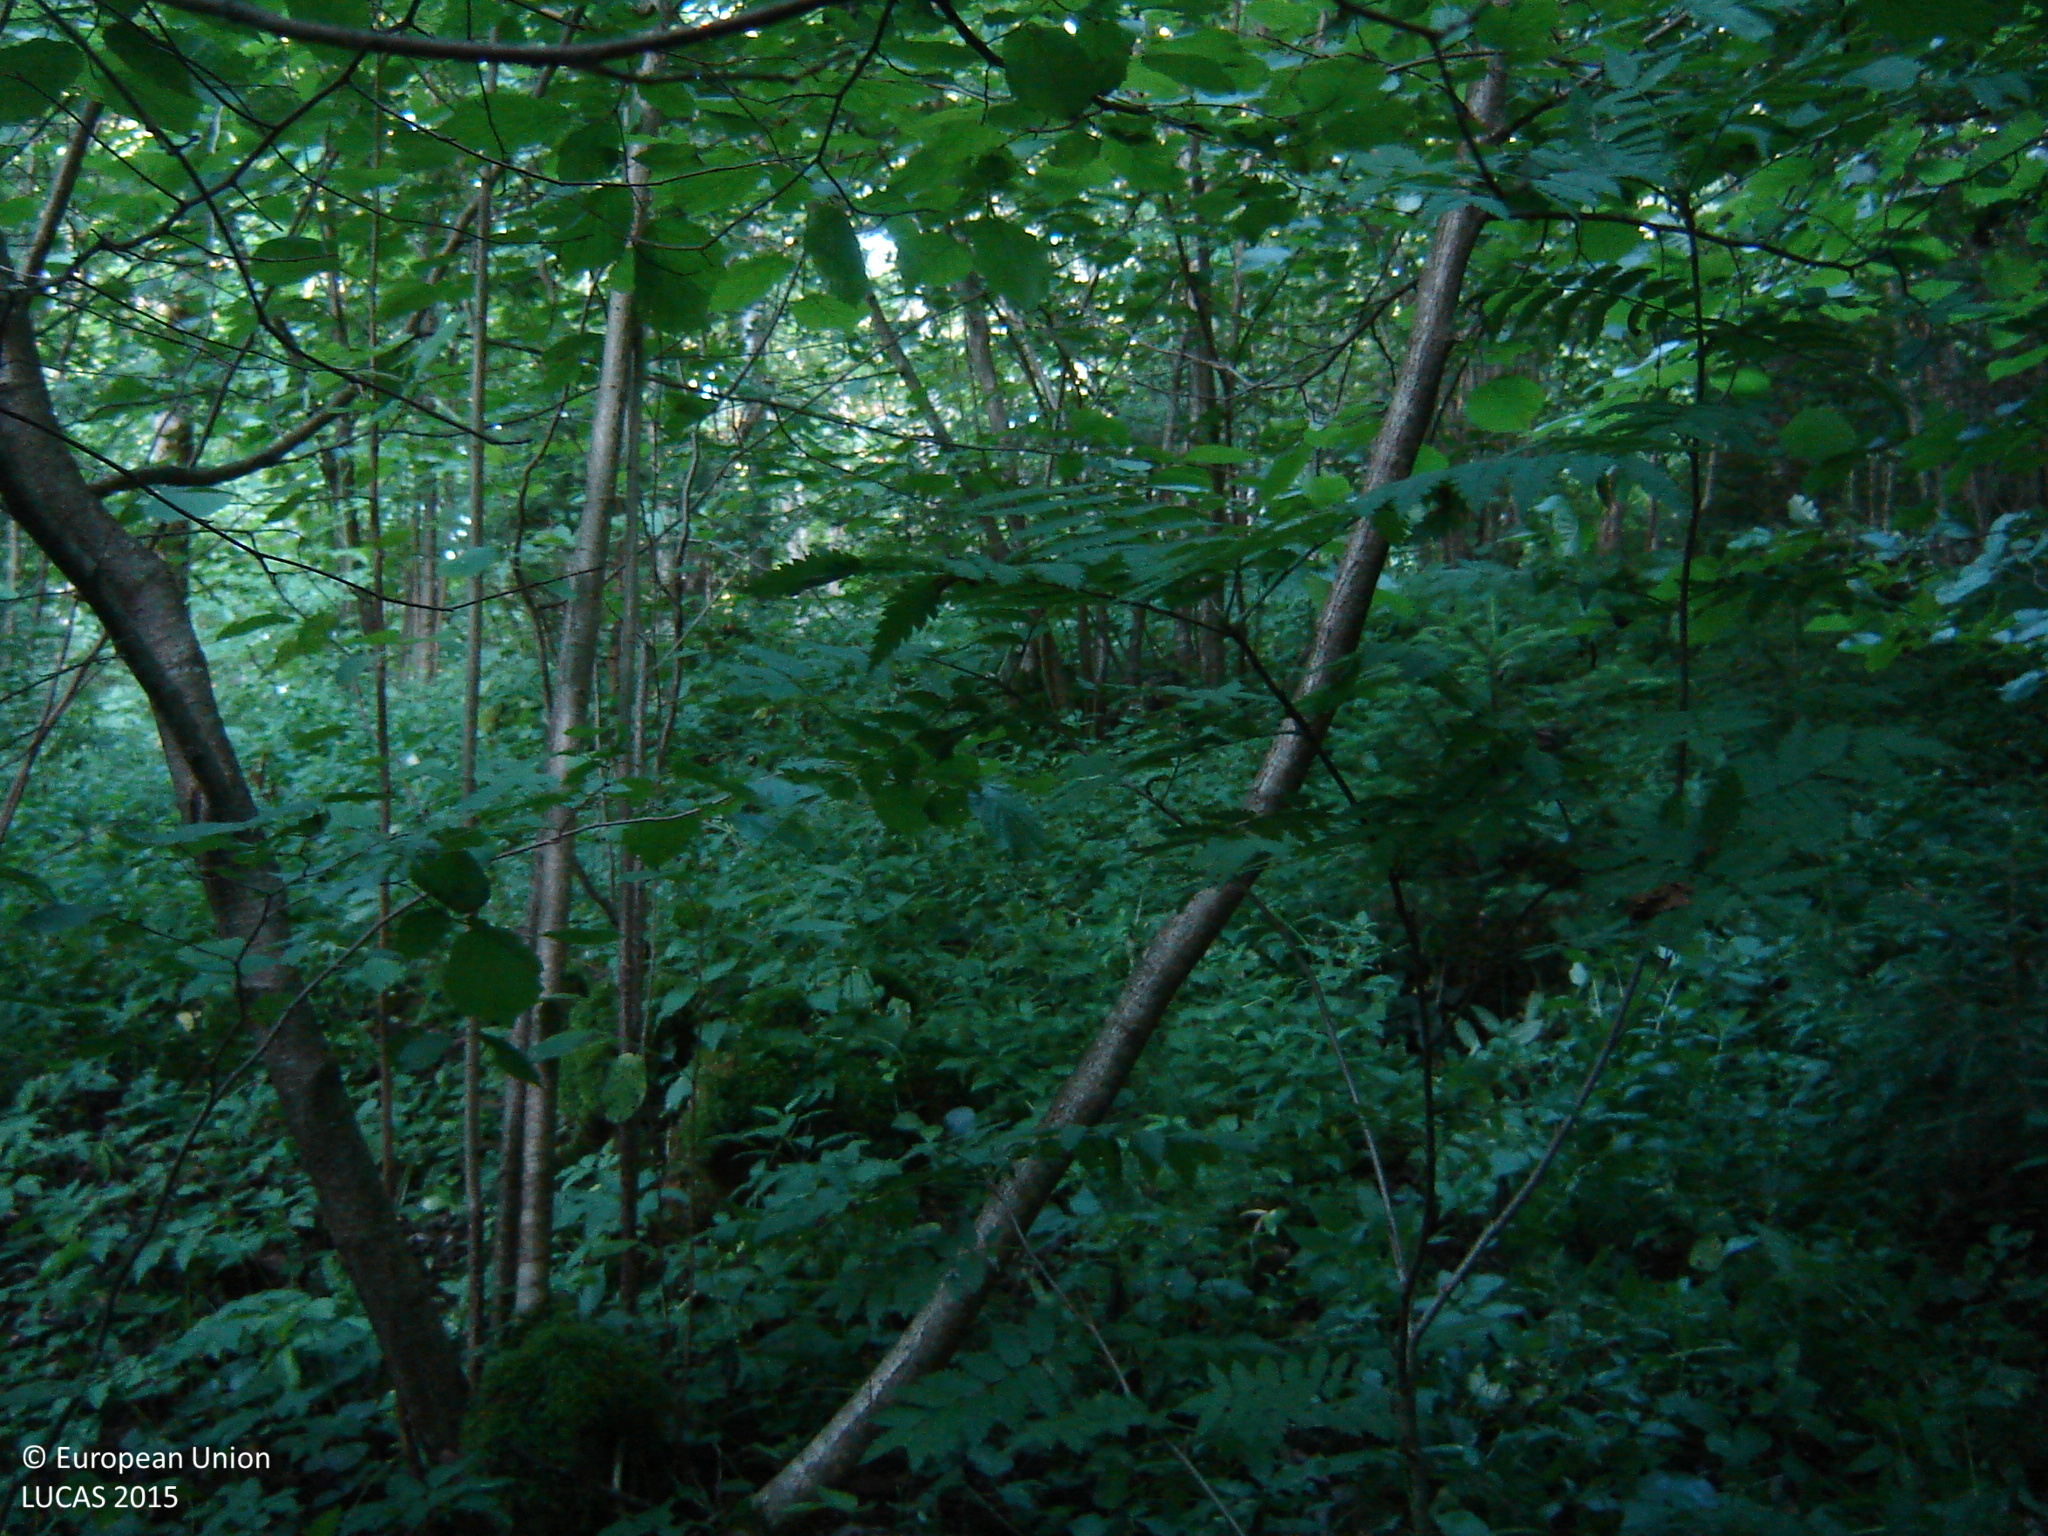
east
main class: Woodland
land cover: Broadleaved woodland
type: non-riverine alder, birch or aspen forest
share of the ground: > 75 %
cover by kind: broadleaved forest trees 85 %, coniferous forest trees 10 %, herbaceous plants 5 %
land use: Forestry
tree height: > 5 m
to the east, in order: Broadleaved woodland; Other mixed woodland; Spruce dominated coniferous woodland; Ditches and canals; Broadleaved woodland; Pine dominated coniferous woodland; Grassland without tree/shrub cover; Tracks; Grassland without tree/shrub cover
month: July
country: LT
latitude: 55.4918
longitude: 25.0705
